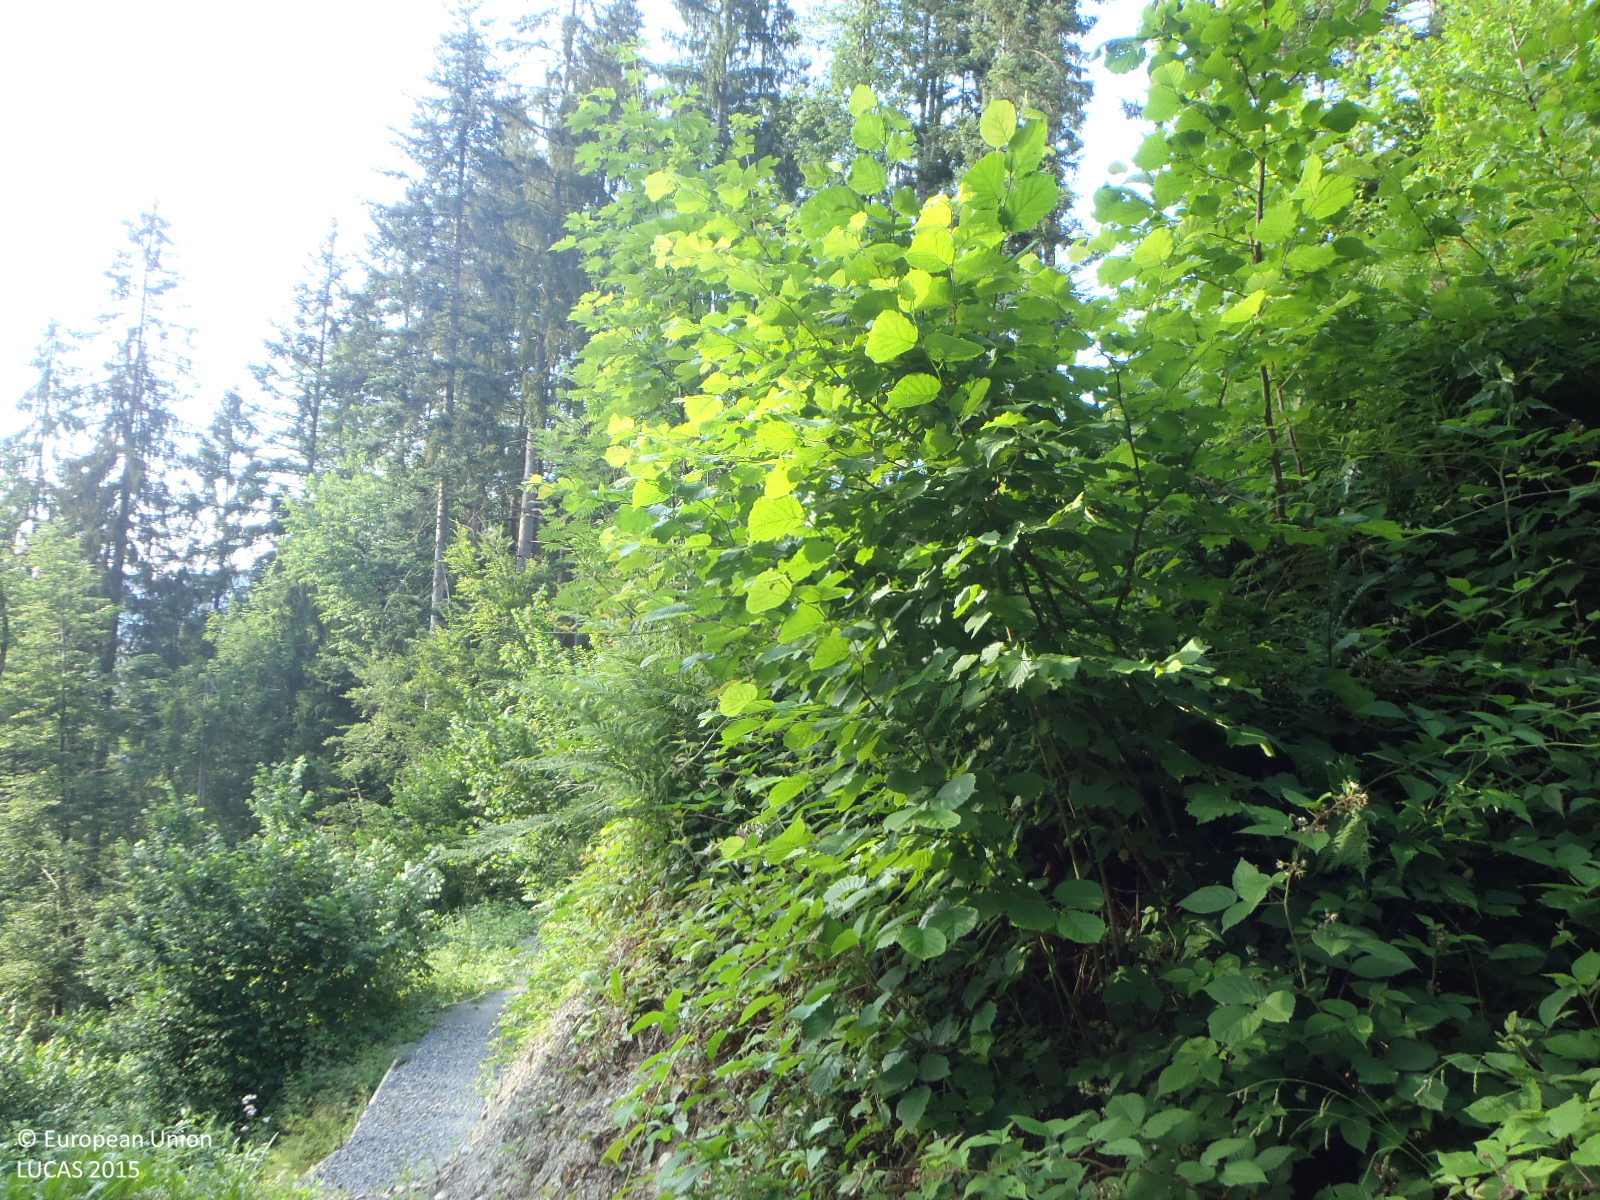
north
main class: Woodland
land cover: Other mixed woodland
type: alpine coniferous forest
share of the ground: > 75 %
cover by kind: coniferous forest trees 35 %, broadleaved forest trees 30 %, shrubs 20 %, herbaceous plants 15 %
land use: Forestry
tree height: > 5 m
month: July
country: AT
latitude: 47.5126
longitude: 12.4283
